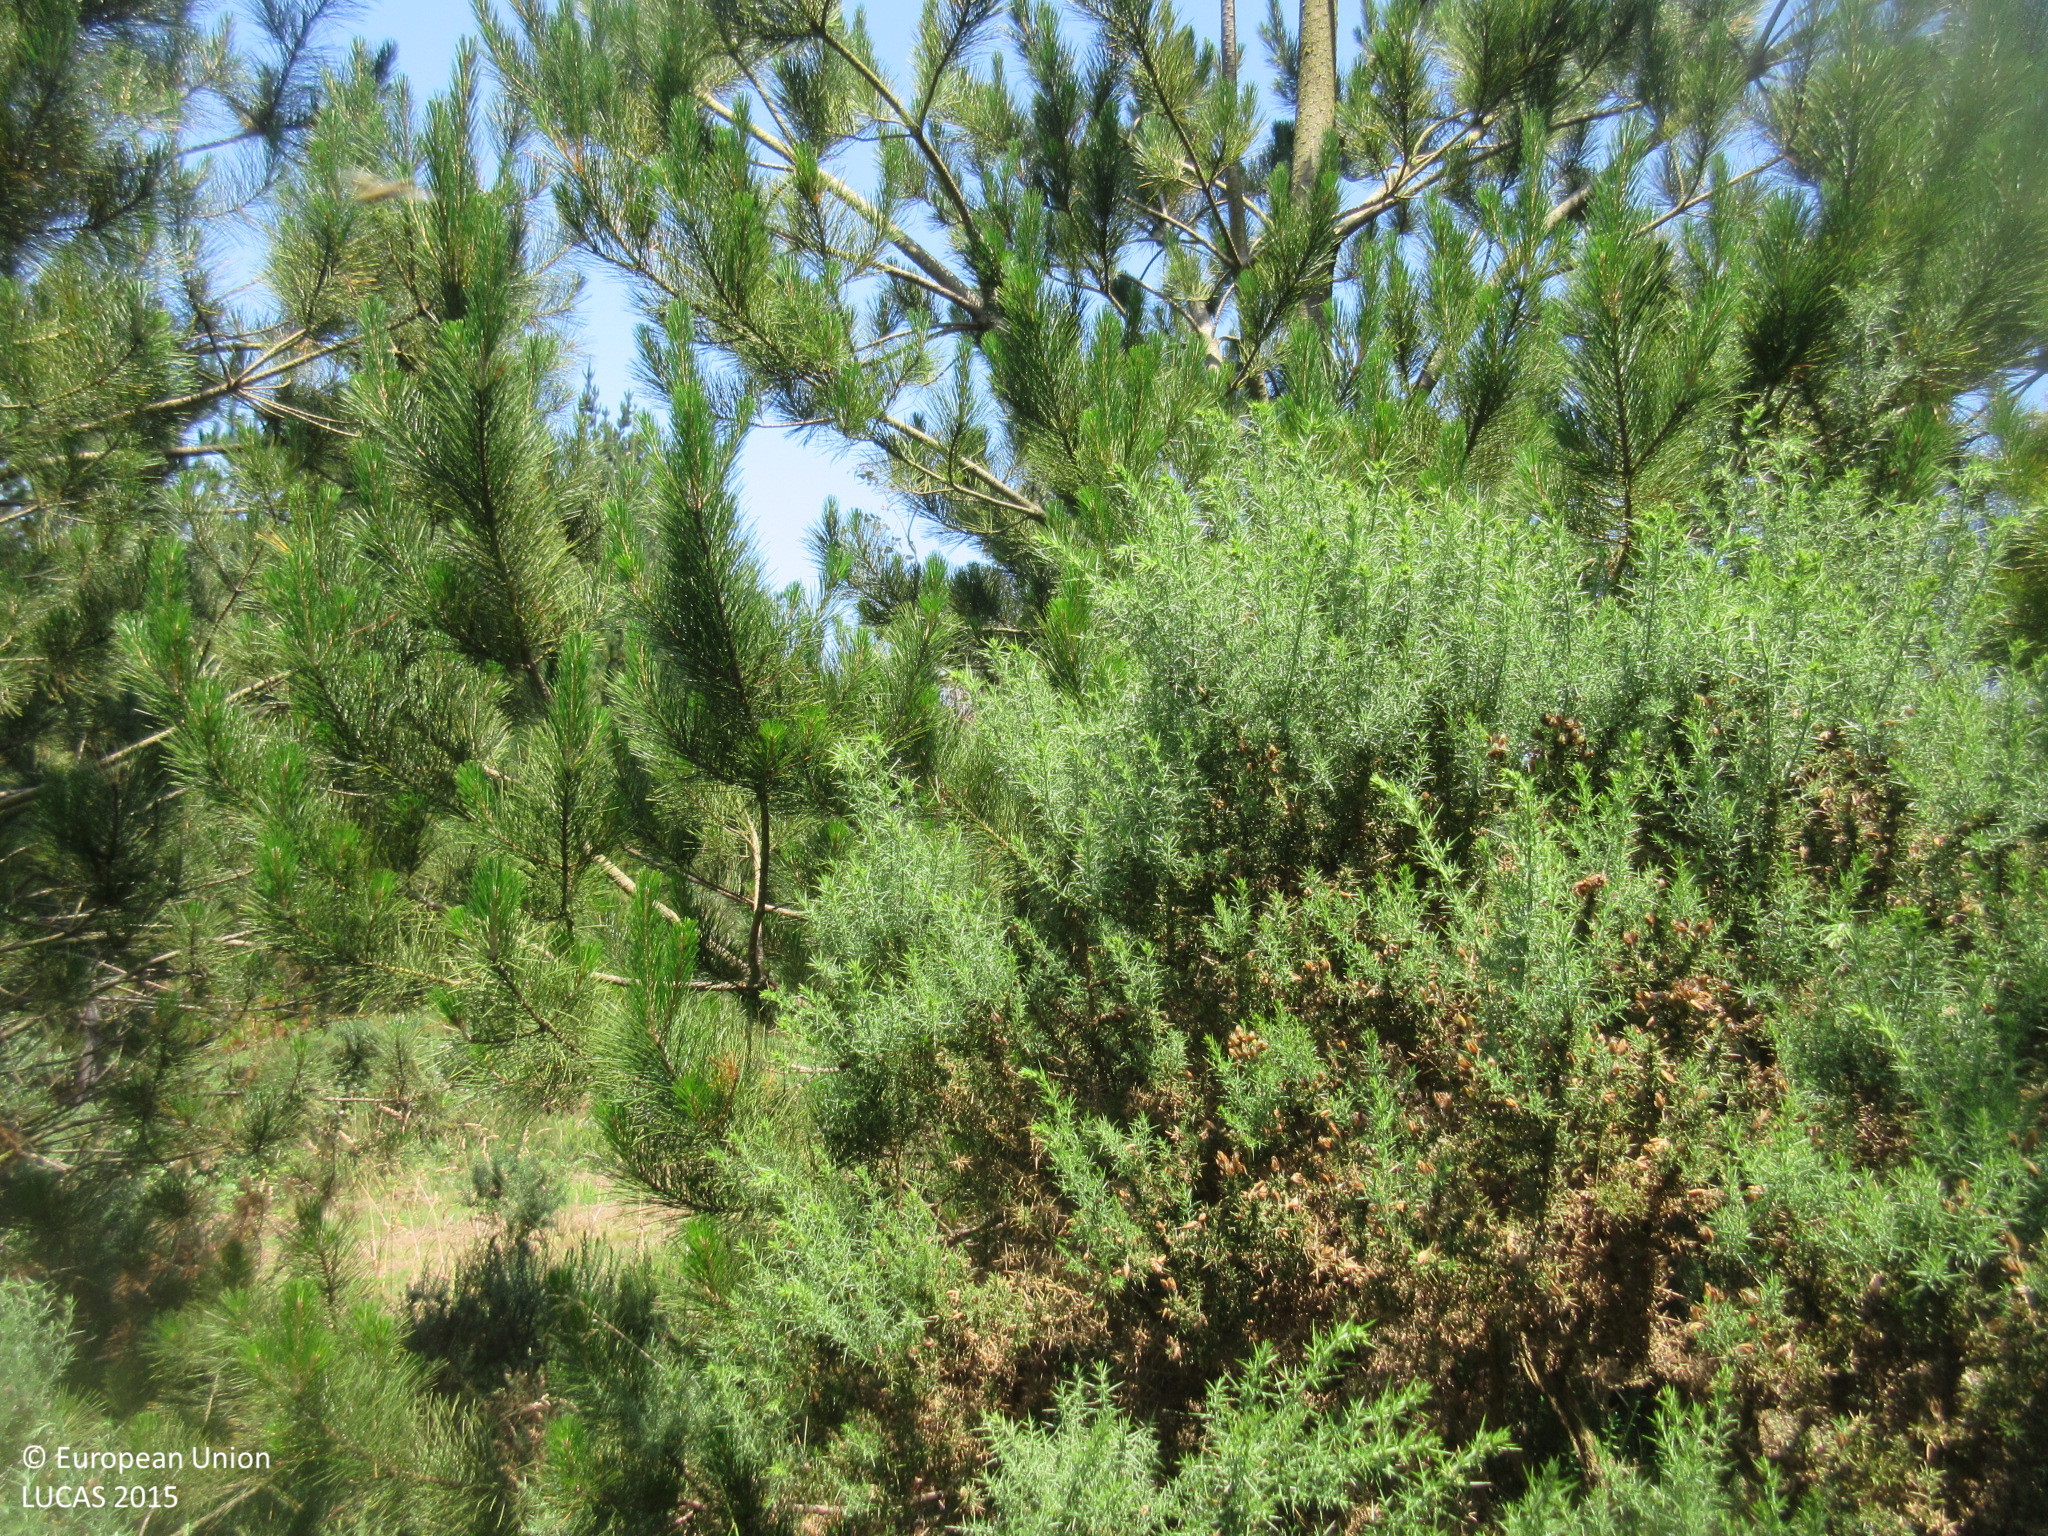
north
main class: Woodland
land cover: Pine dominated coniferous woodland
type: hemiboreal forest and nemoral coniferous forest and mixed broadleaved-coniferous forest
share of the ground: > 75 %
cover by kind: coniferous forest trees 80 %, shrubs 20 %
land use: Forestry
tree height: > 5 m
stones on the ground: 10 - 25 %
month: June
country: ES
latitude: 43.3678
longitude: -7.1625
